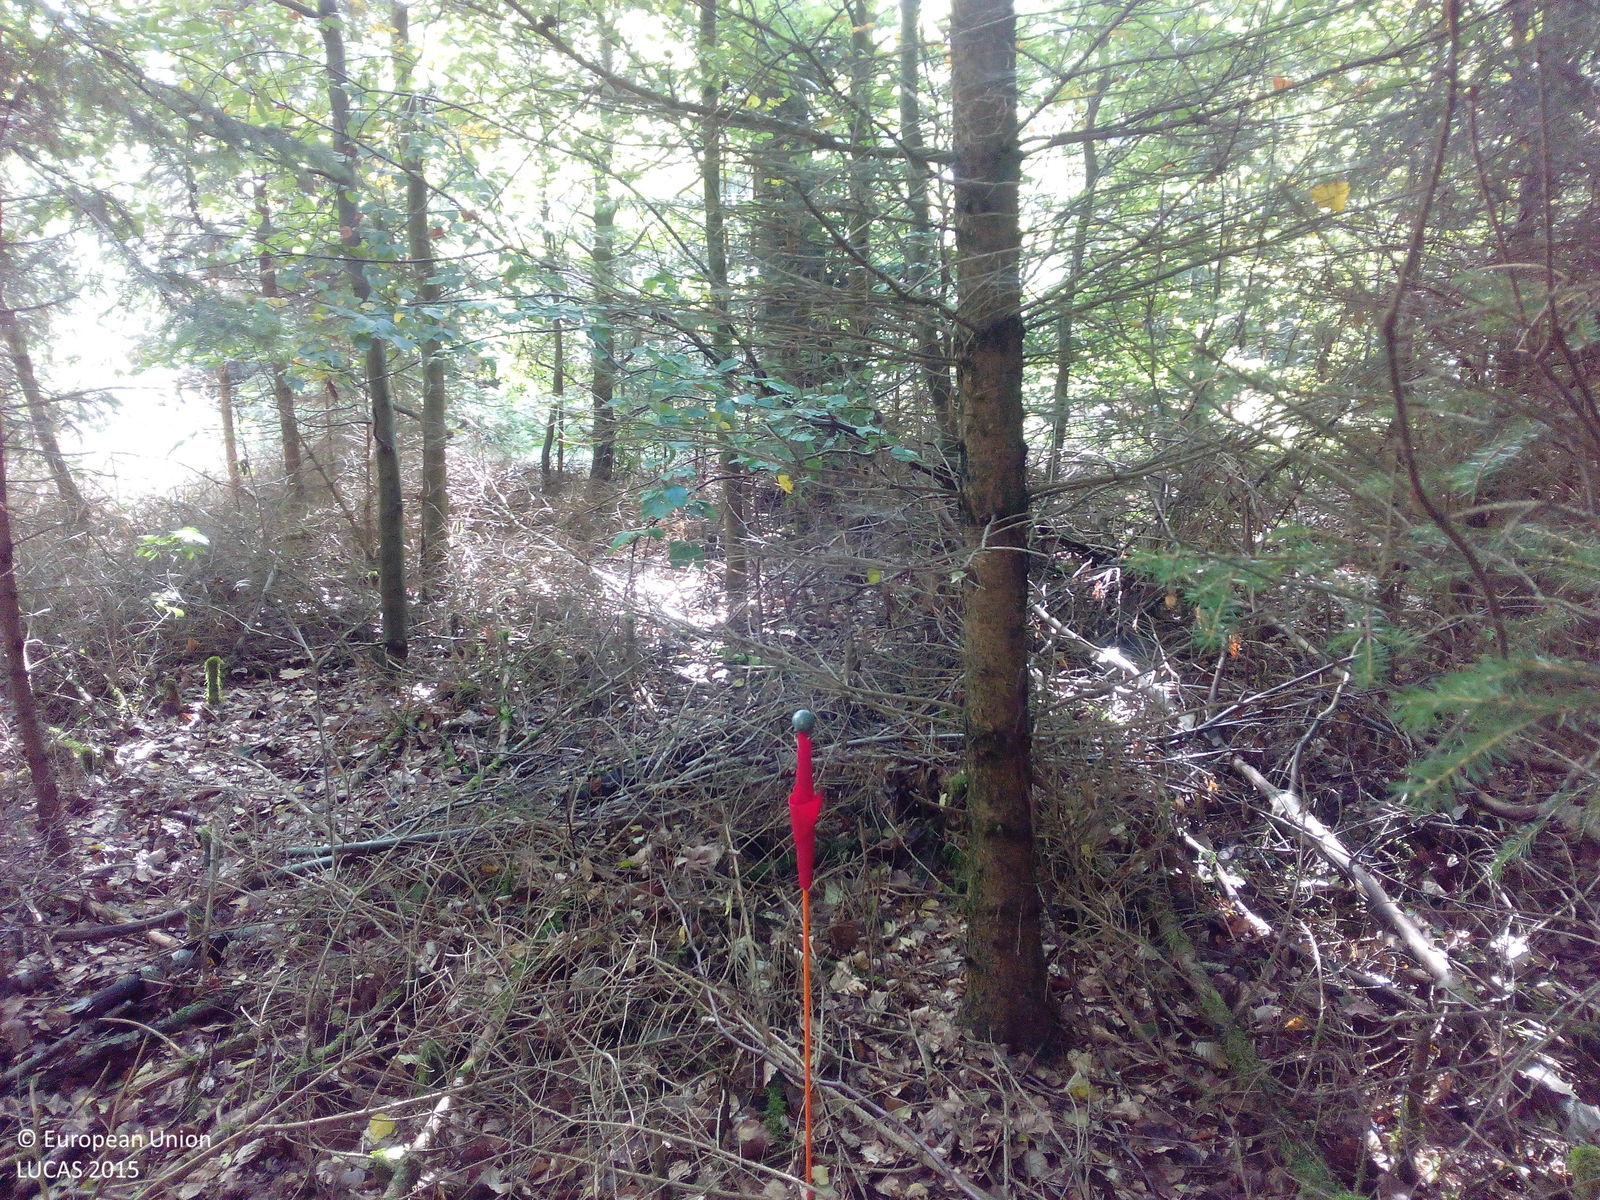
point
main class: Woodland
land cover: Spruce dominated coniferous woodland
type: hemiboreal forest and nemoral coniferous forest and mixed broadleaved-coniferous forest
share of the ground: > 75 %
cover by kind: coniferous forest trees 90 %, broadleaved forest trees 10 %
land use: Forestry
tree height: > 5 m
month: September
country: DE
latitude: 51.7837
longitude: 9.6377
